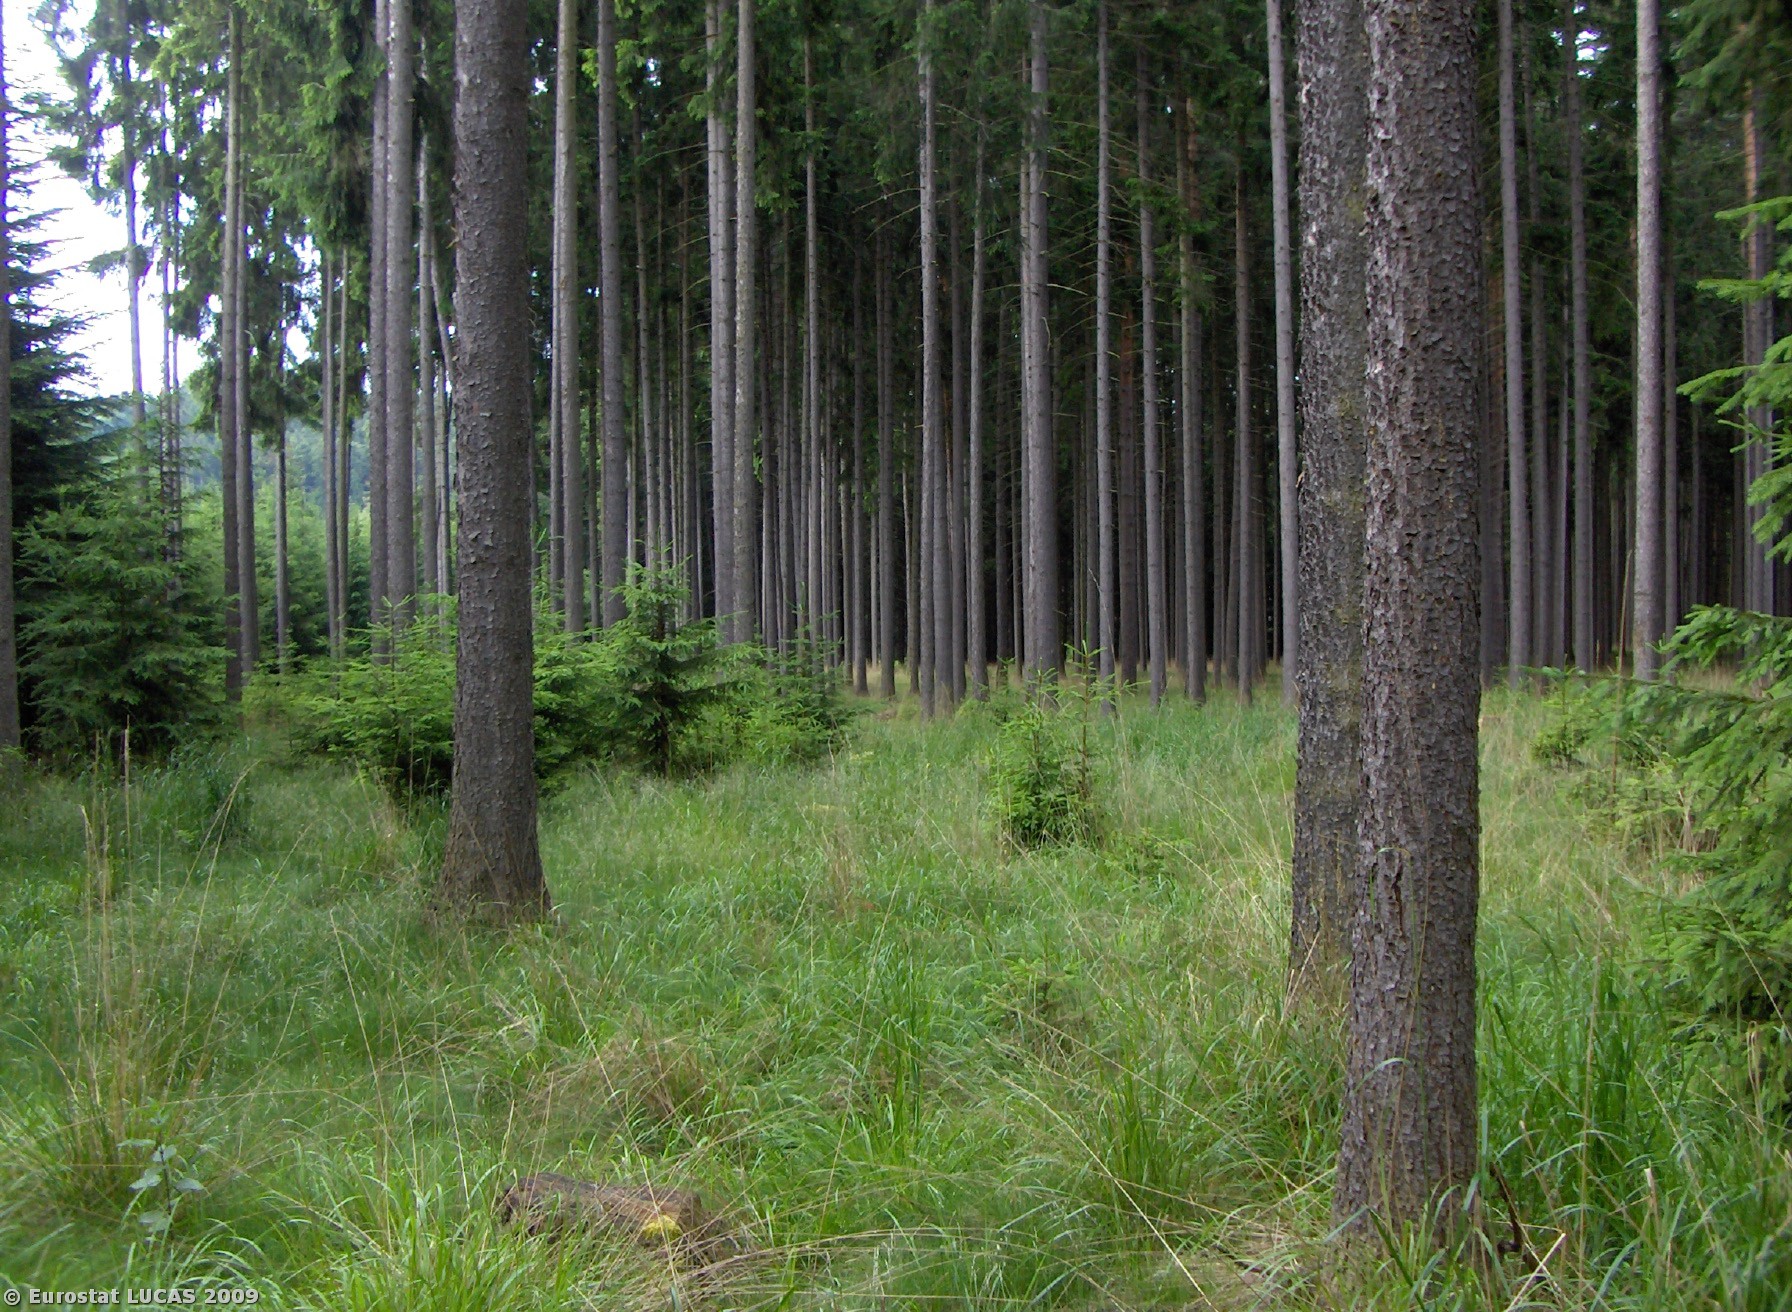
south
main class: Woodland
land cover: Coniferous woodland
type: hemiboreal forest and nemoral coniferous forest and mixed broadleaved-coniferous forest
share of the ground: > 75 %
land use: Forestry
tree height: > 5 m
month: June
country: CZ
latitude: 49.1012
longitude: 14.1234
